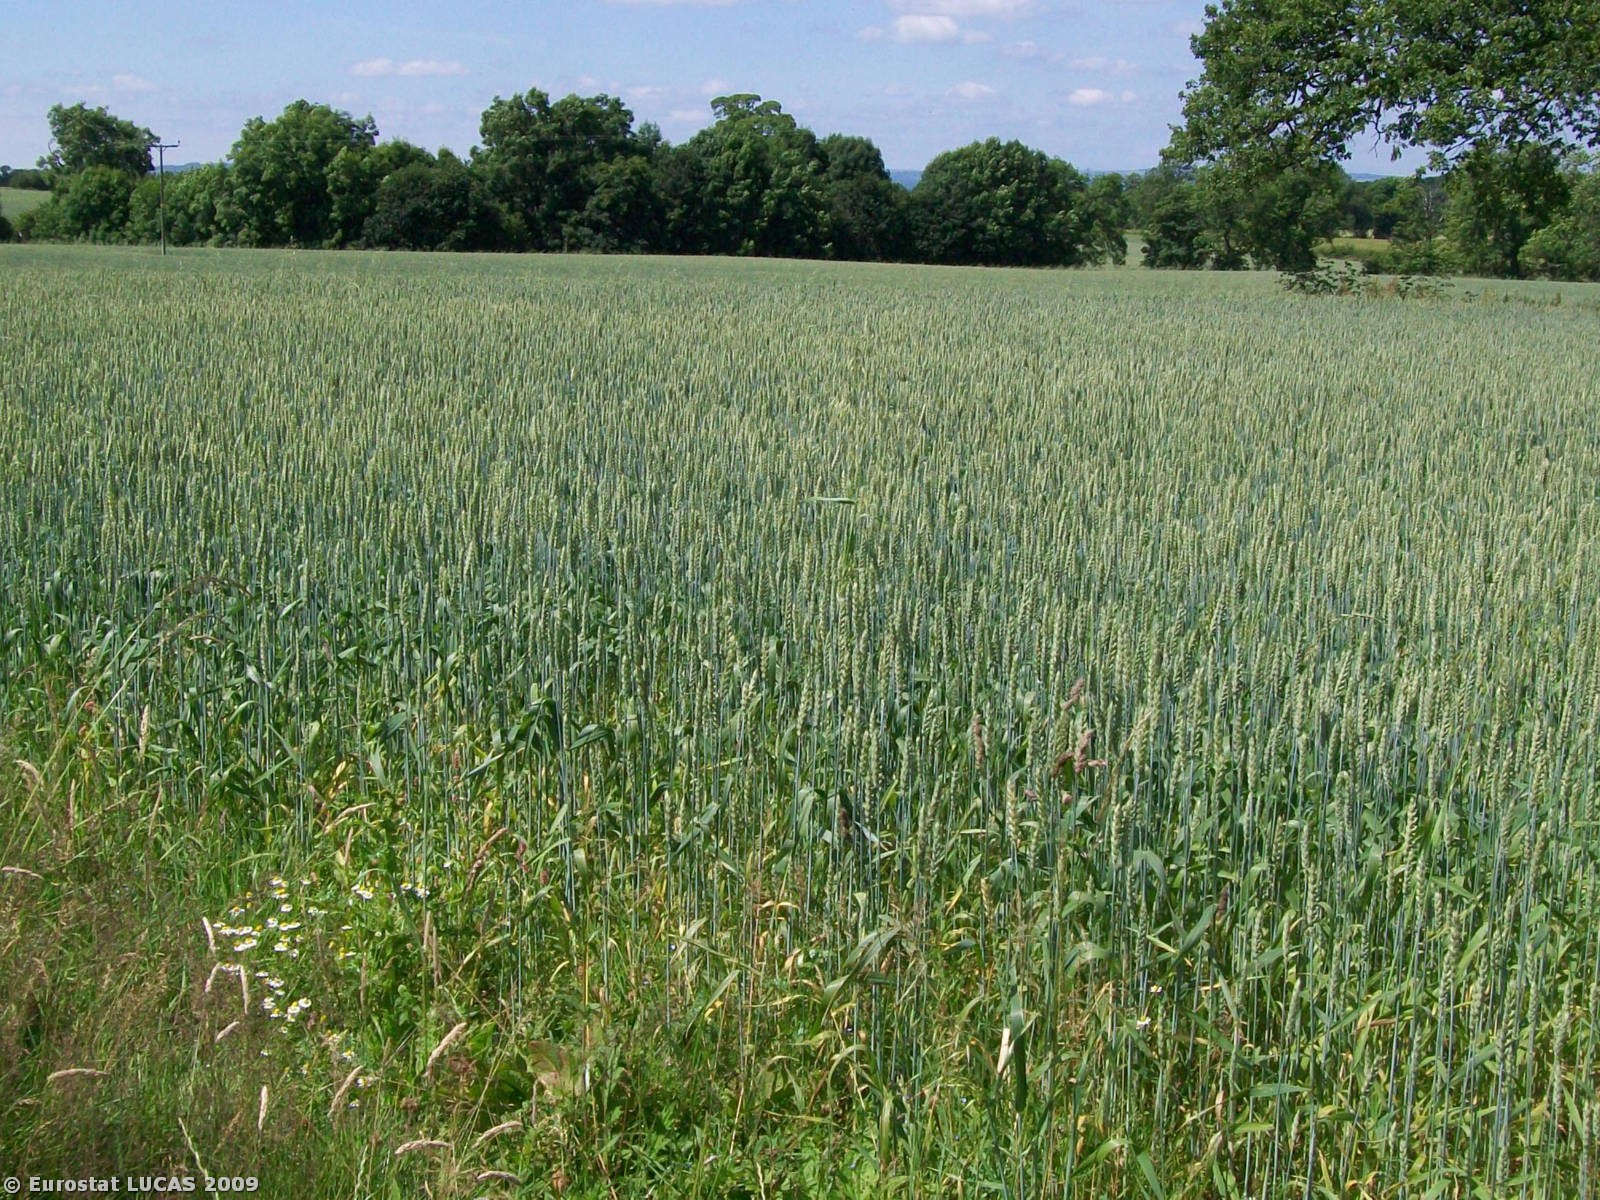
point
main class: Cropland
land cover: Common wheat
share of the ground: < 10 %
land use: Agriculture (excluding fallow land and kitchen gardens)
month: July
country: GB
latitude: 54.3588
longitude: -1.5132
